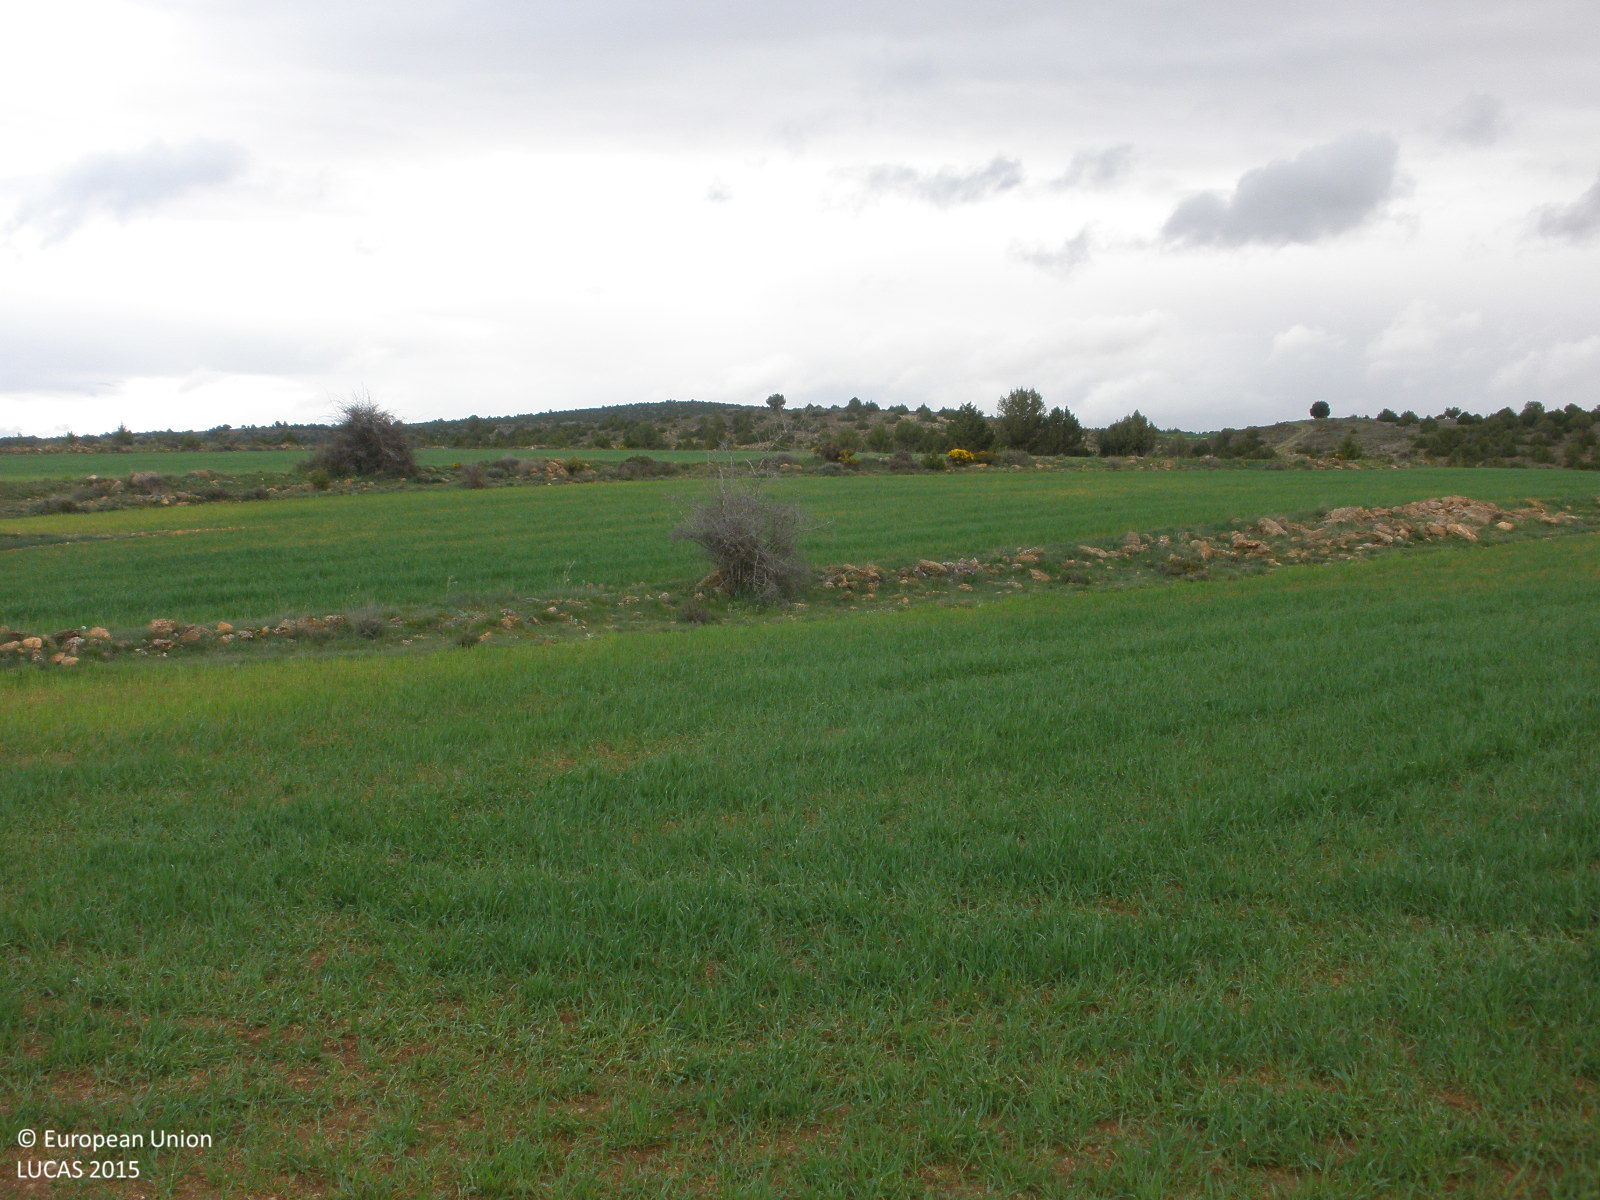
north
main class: Cropland
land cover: Barley
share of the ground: 50 - 75 %
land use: Agriculture (excluding fallow land and kitchen gardens)
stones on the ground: 25 - 50 %
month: April
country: ES
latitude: 40.3269
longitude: -1.2751
